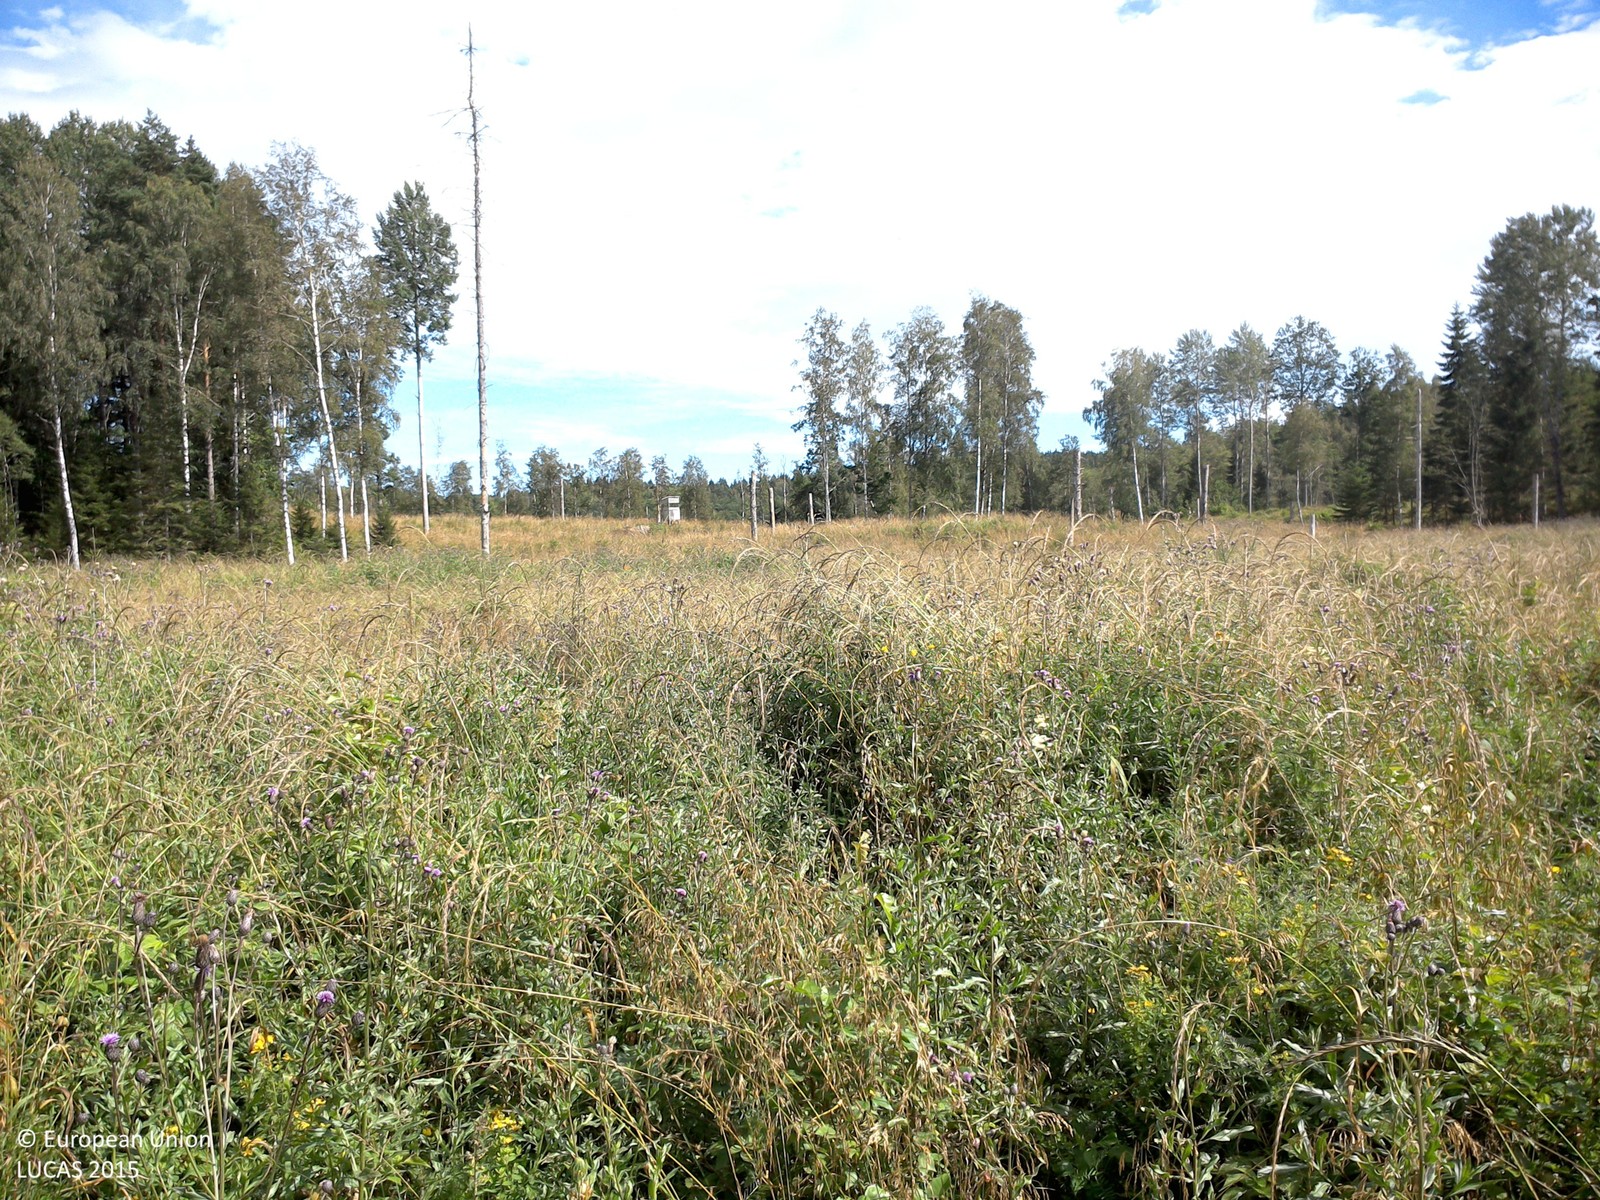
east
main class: Shrubland
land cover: Shrubland without tree cover
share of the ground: > 75 %
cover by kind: shrubs 90 %, herbaceous plants 10 %
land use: Forestry
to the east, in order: Shrubland without tree cover; Shrubland with sparse tree cover; Broadleaved woodland; Shrubland with sparse tree cover; Broadleaved woodland; Inland marshes; Inland fresh water bodies
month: August
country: SE
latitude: 58.1660
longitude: 14.9069
